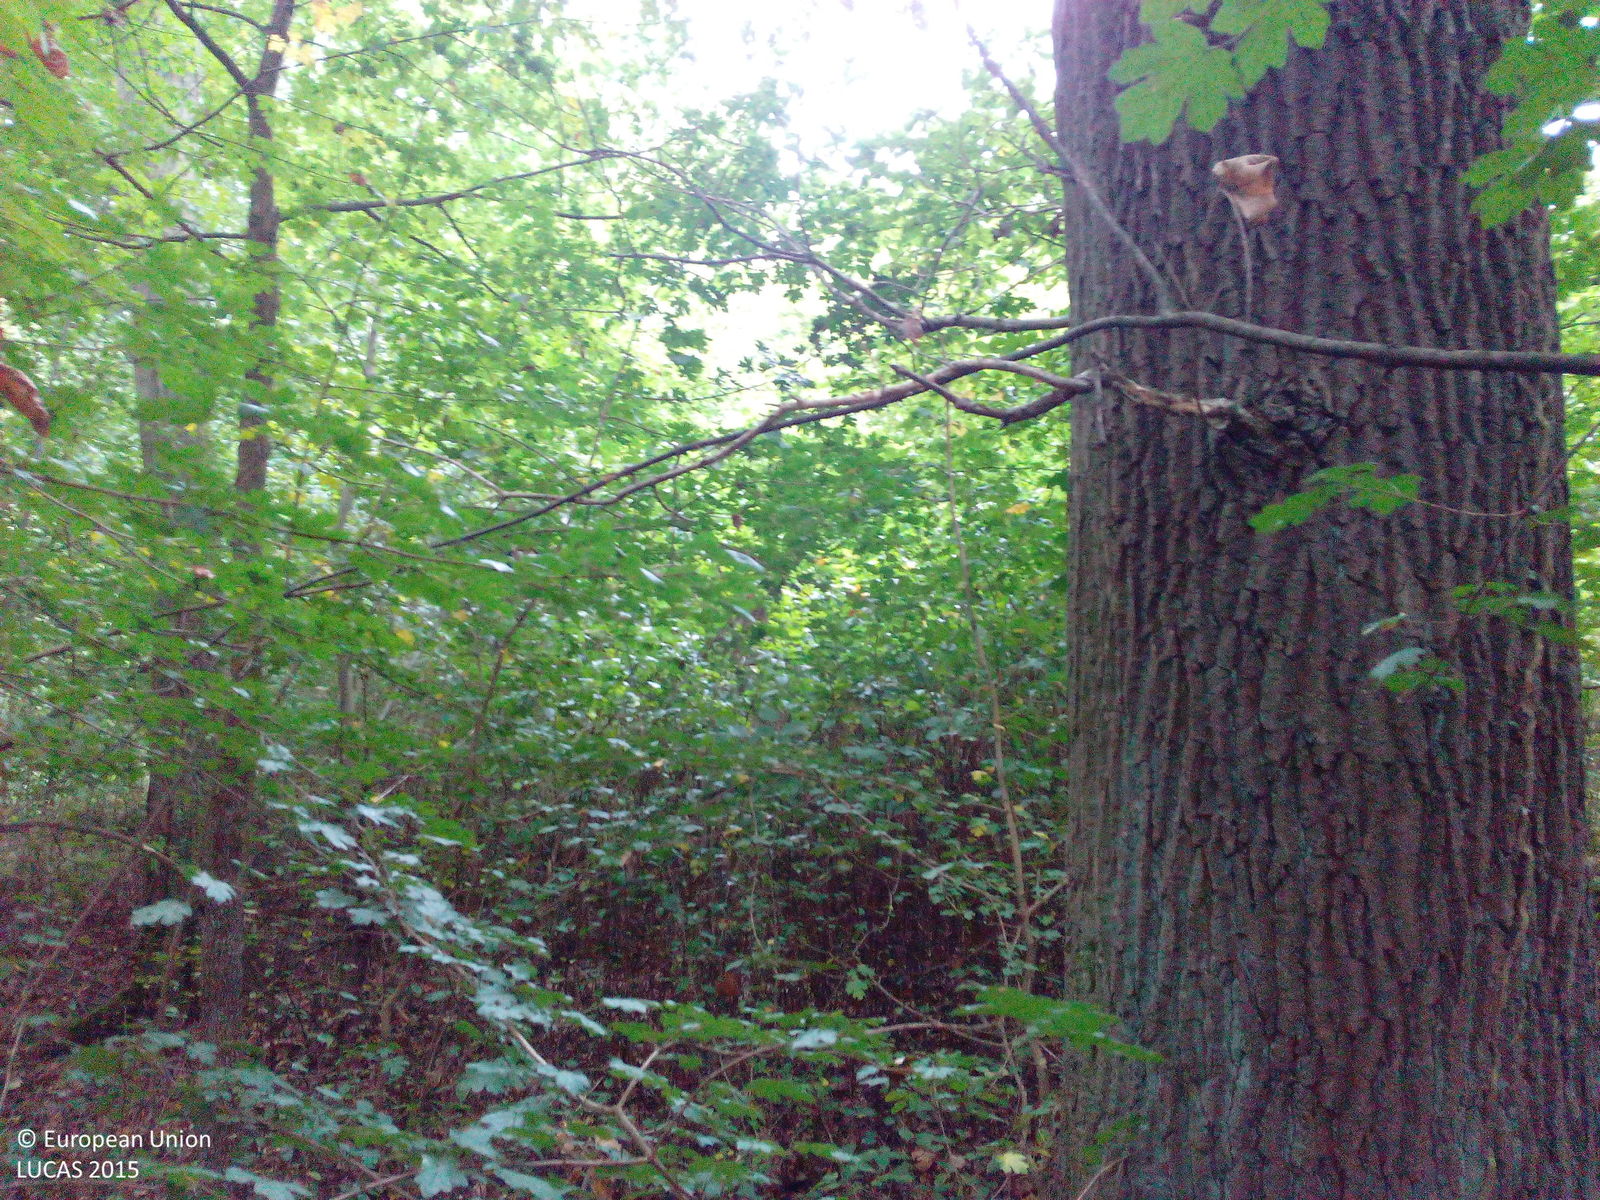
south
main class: Woodland
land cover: Broadleaved woodland
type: mesophytic deciduous forest
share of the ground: > 75 %
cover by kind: broadleaved forest trees 100 %
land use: Forestry
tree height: > 5 m
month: September
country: DE
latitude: 51.5505
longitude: 9.8414
